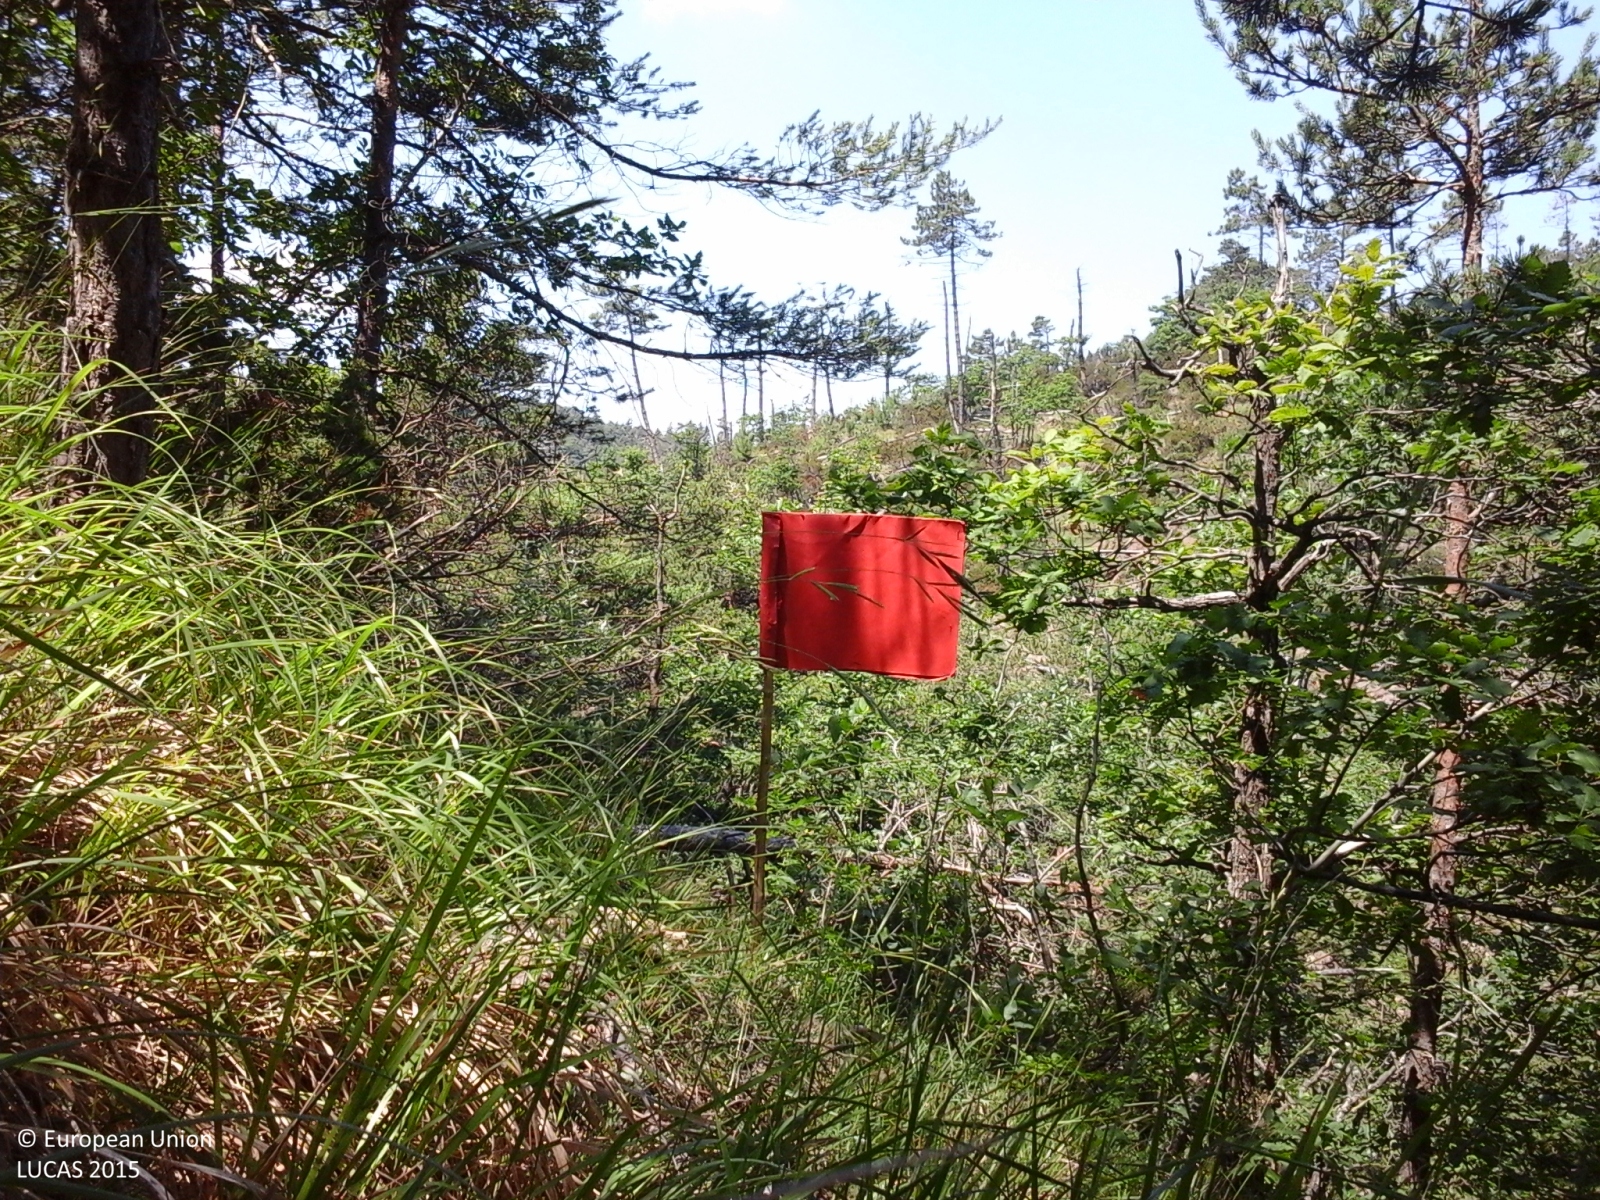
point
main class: Woodland
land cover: Pine dominated mixed woodland
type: coniferous forest of the mediterranean region
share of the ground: > 75 %
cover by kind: coniferous forest trees 45 %, broadleaved forest trees 25 %, shrubs 15 %, herbaceous plants 10 %, consolidated bare surface 5 %
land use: Forestry
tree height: > 5 m
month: June
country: IT
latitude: 44.5202
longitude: 8.5060
